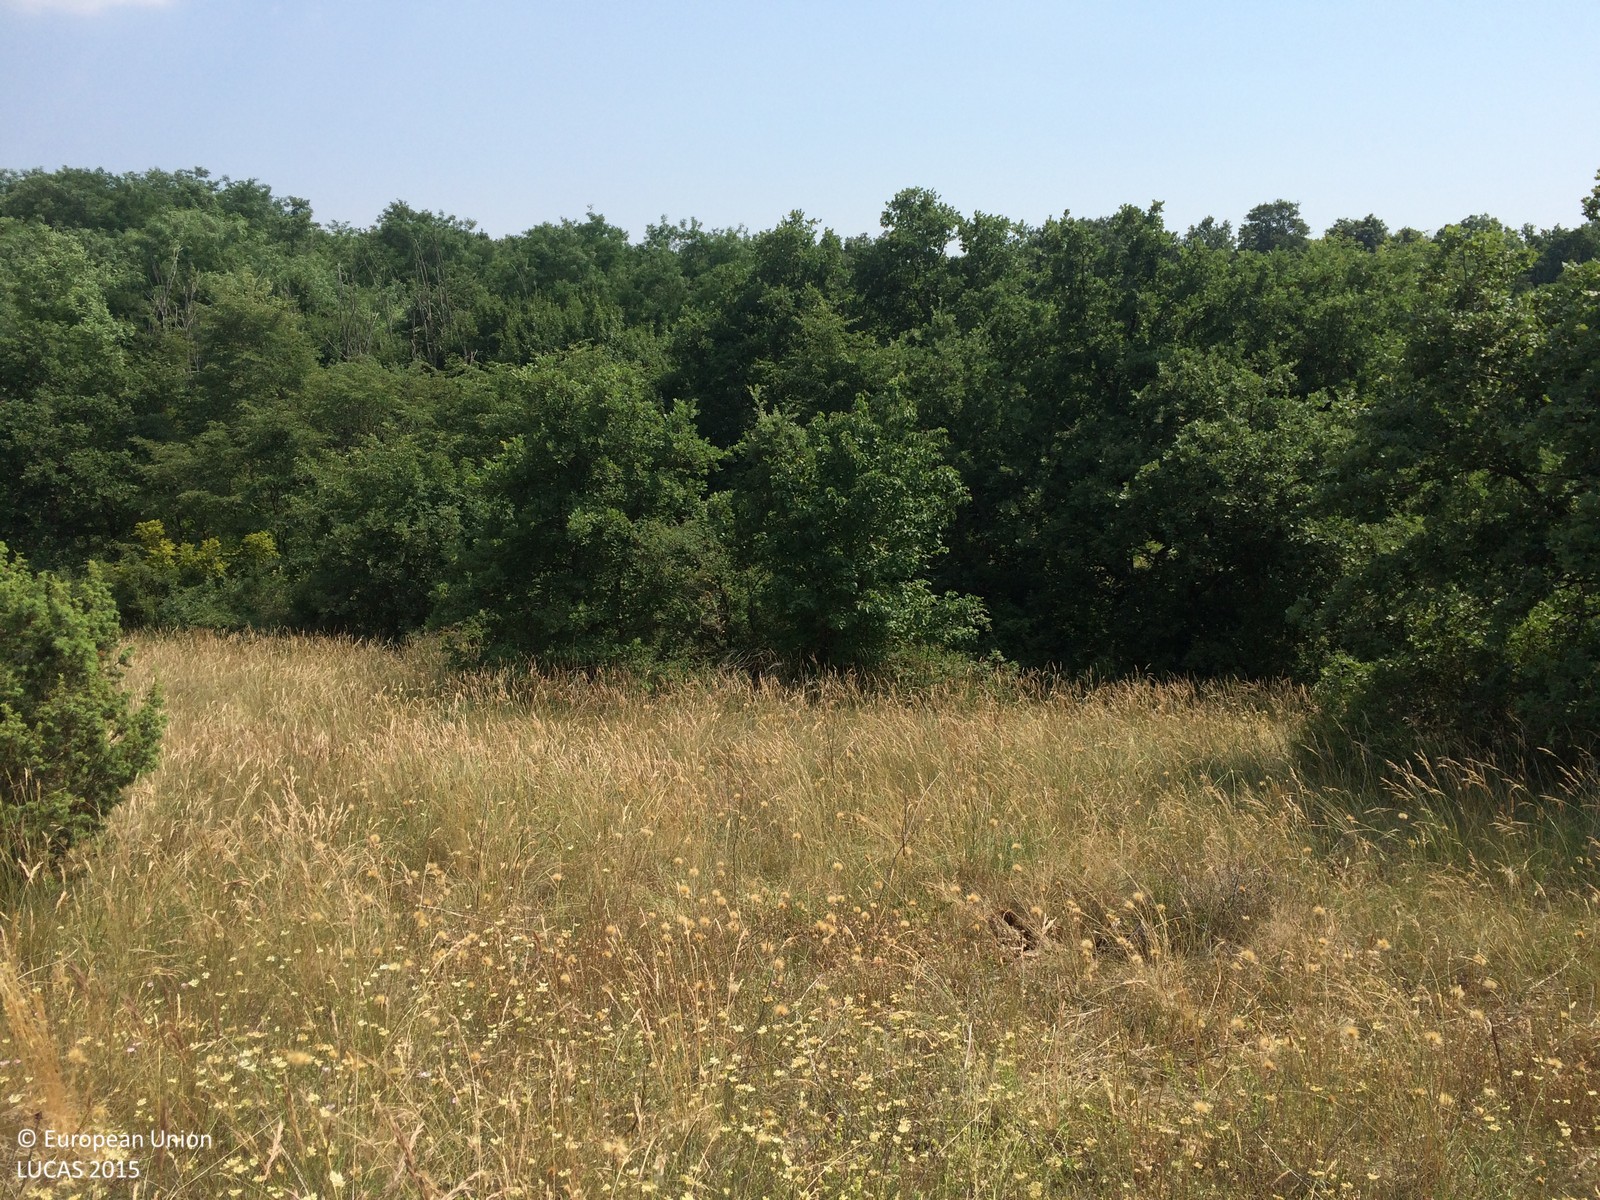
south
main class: Grassland
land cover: Grassland with sparse tree/shrub cover
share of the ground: > 75 %
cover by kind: herbaceous plants 90 %, broadleaved forest trees 5 %, shrubs 5 %
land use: Semi-natural and natural areas not in use
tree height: < 5 m
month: June
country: HR
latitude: 45.0925
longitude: 13.8191
